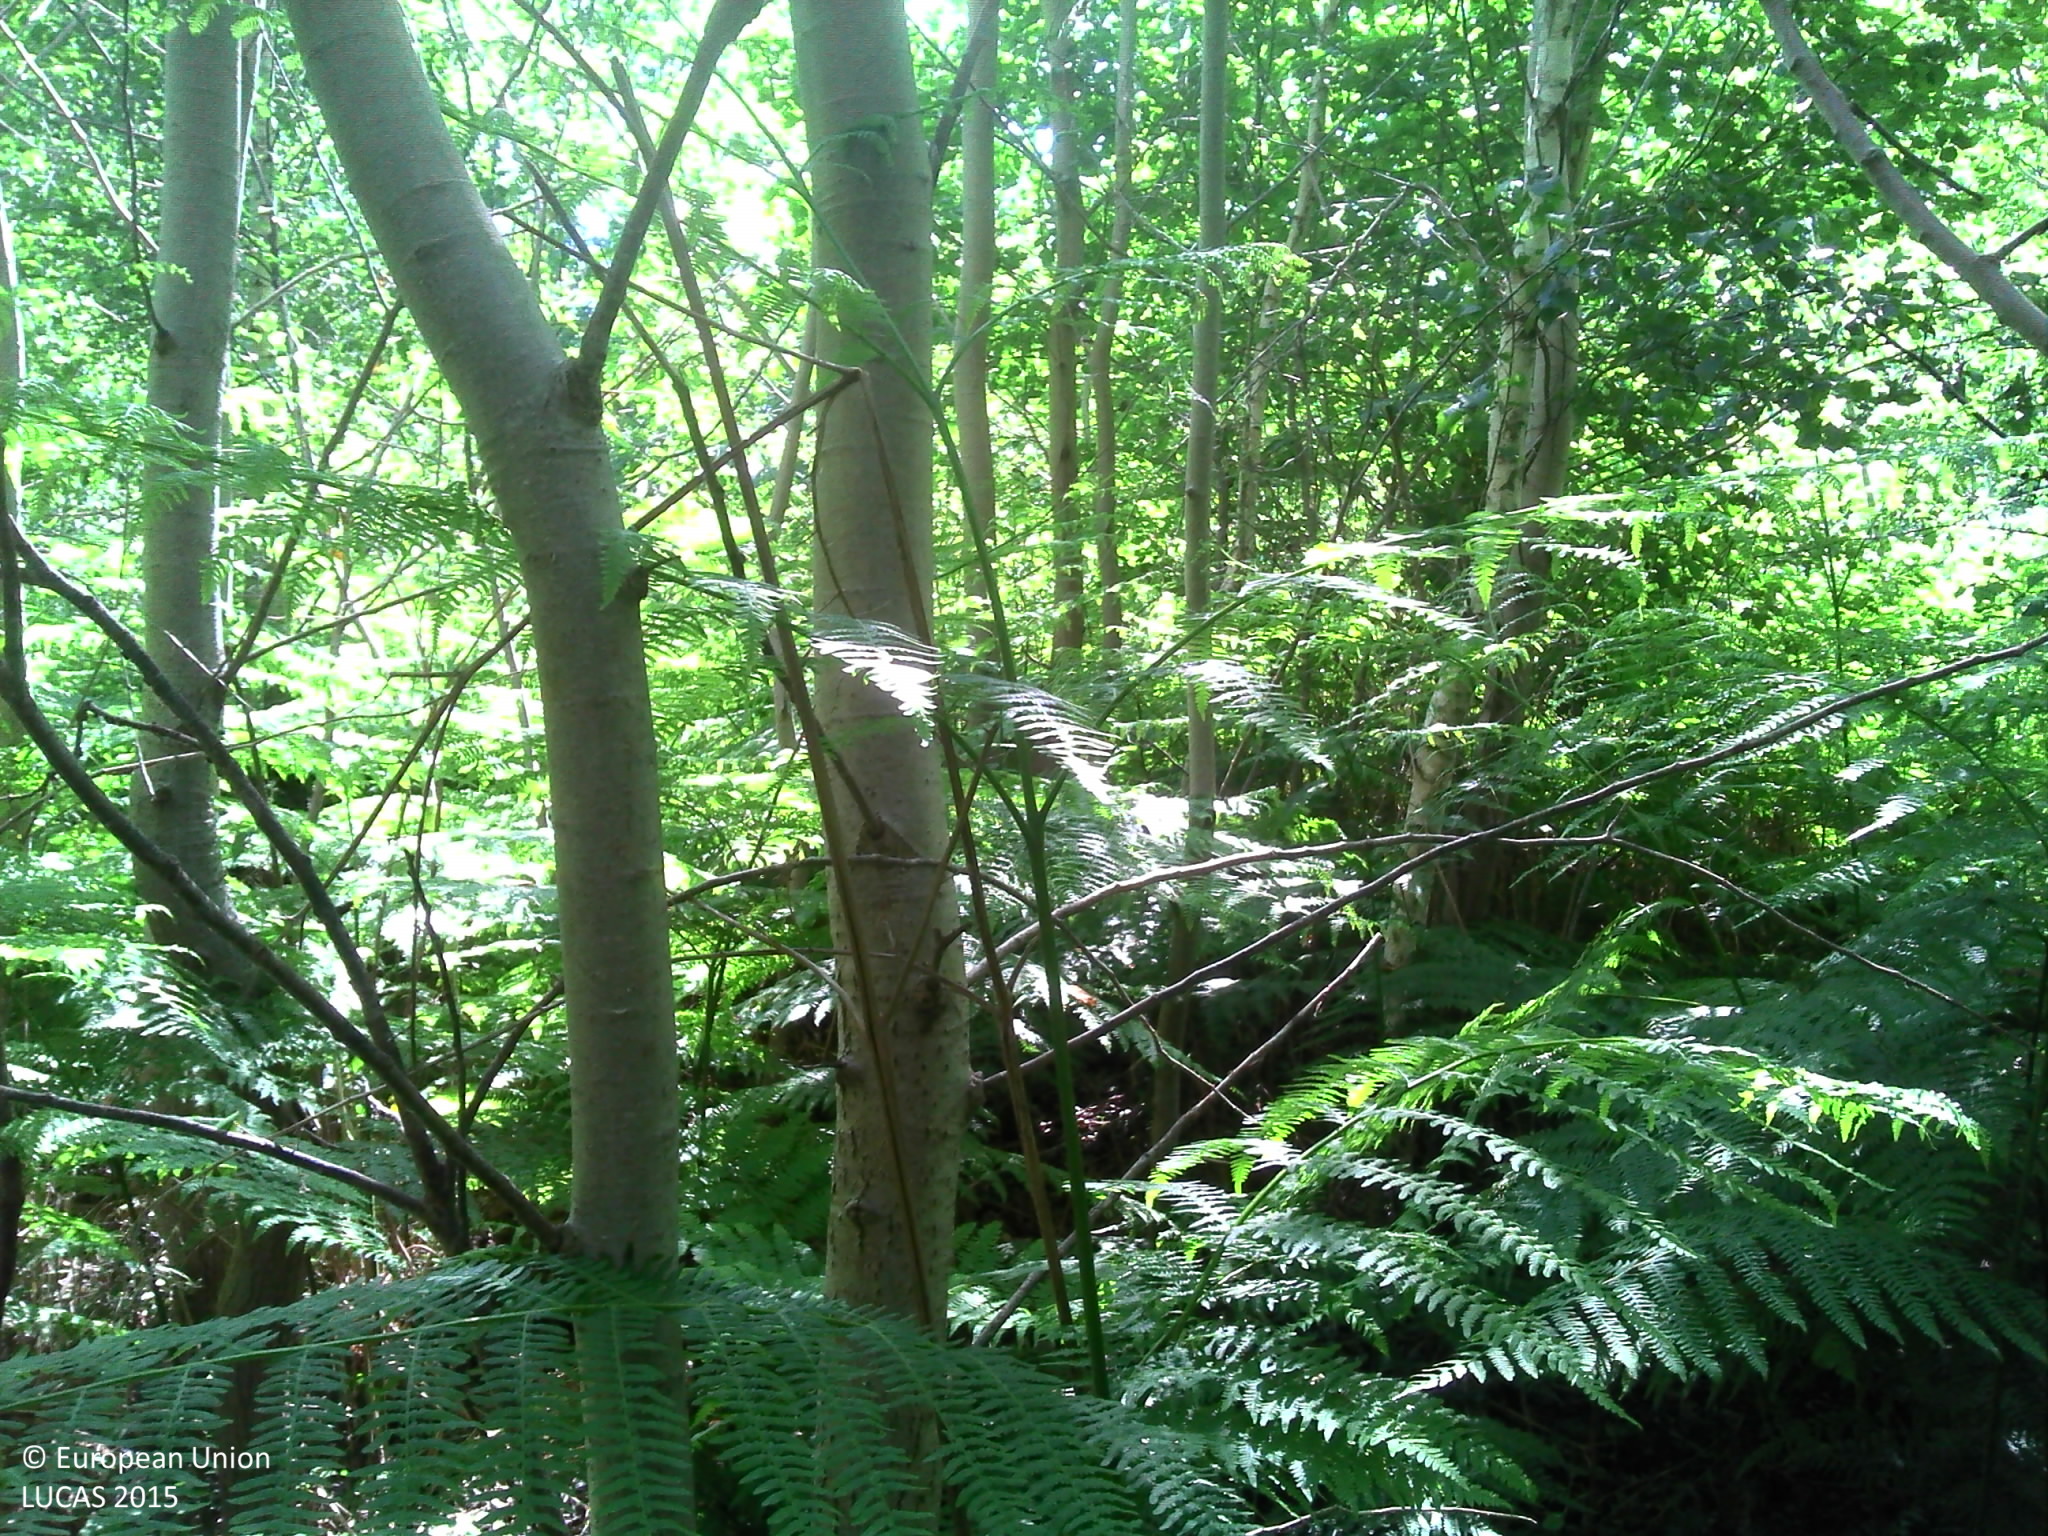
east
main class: Woodland
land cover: Broadleaved woodland
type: non-riverine alder, birch or aspen forest
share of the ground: > 75 %
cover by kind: broadleaved forest trees 80 %, herbaceous plants 20 %
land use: Forestry
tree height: > 5 m
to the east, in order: Broadleaved woodland; Tracks; Broadleaved woodland
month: June
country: FR
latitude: 47.3894
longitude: 0.0259
